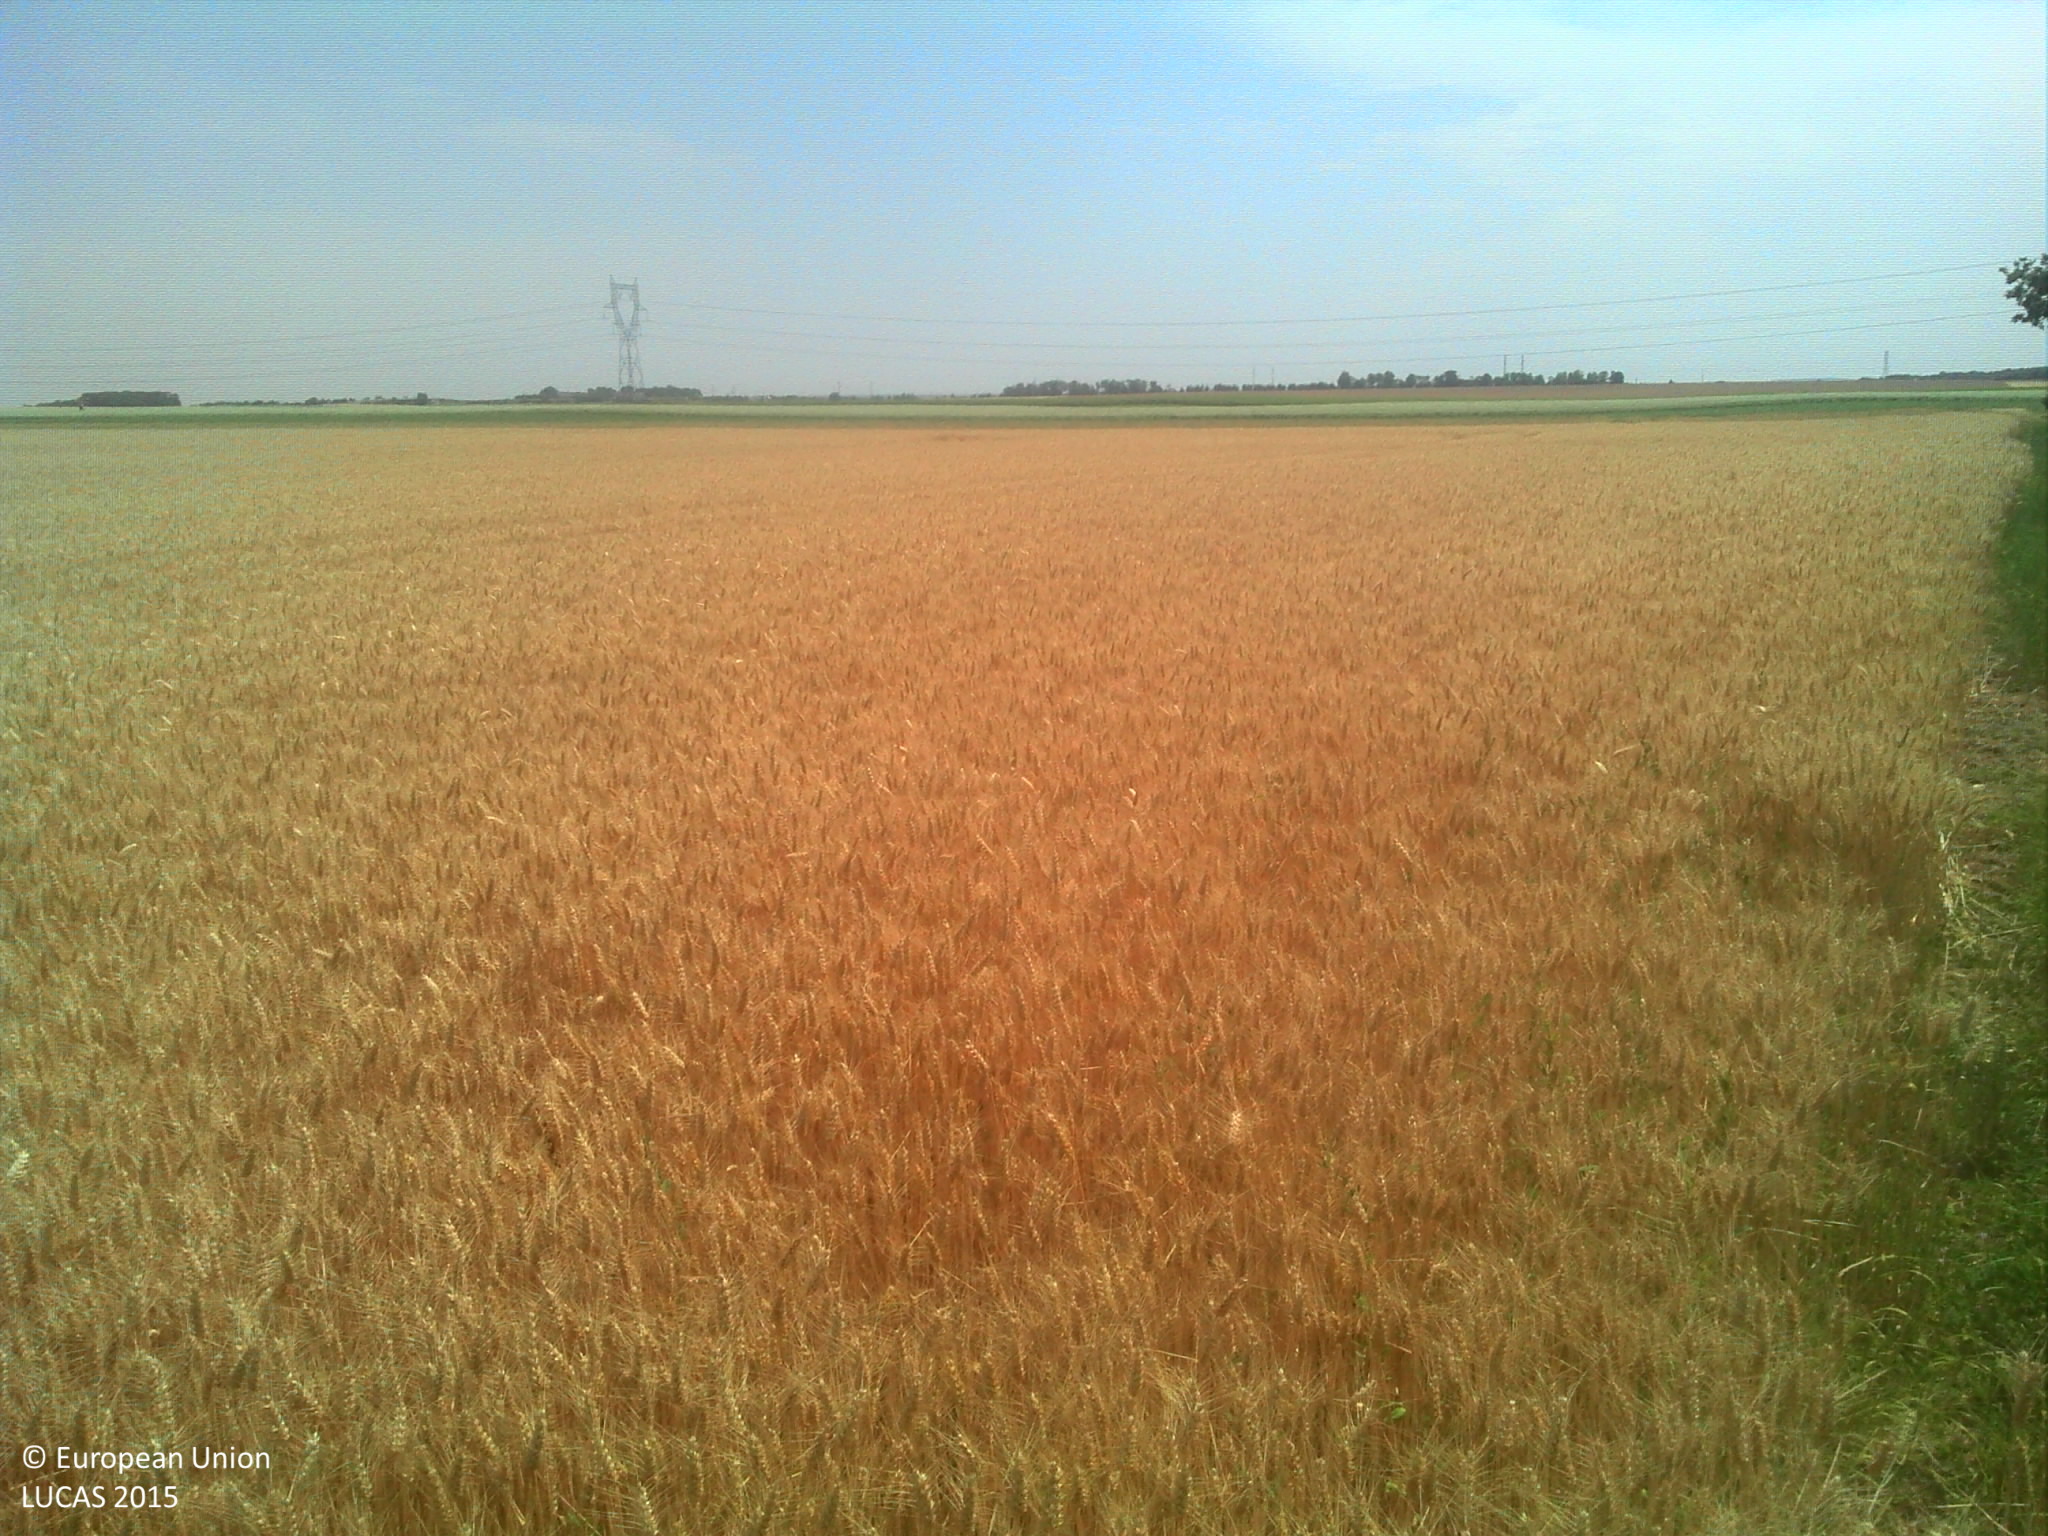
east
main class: Cropland
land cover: Durum wheat
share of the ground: > 75 %
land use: Agriculture (excluding fallow land and kitchen gardens)
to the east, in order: Durum wheat; Grass margins; Tracks; Grass margins; Spontaneously vegetated surfaces
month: July
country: FR
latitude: 47.6873
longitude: 1.3917
